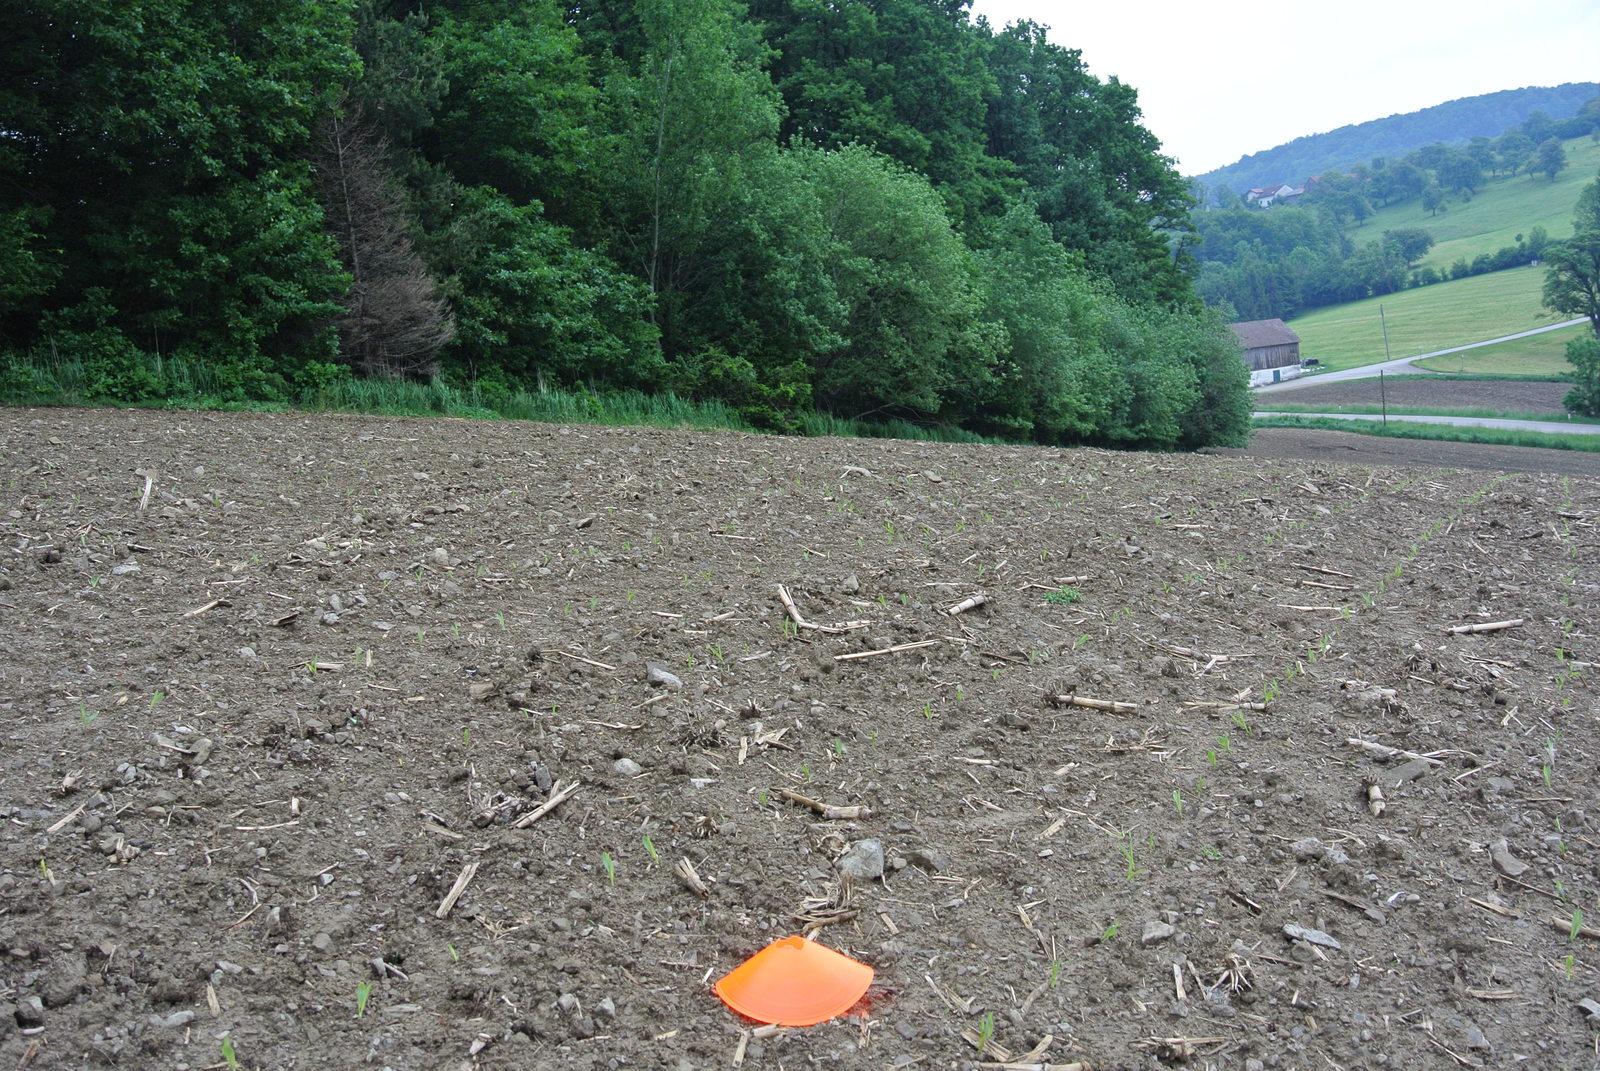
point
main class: Cropland
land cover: Maize
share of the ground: < 10 %
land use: Agriculture (excluding fallow land and kitchen gardens)
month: May
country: AT
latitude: 48.1046
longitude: 15.8450
